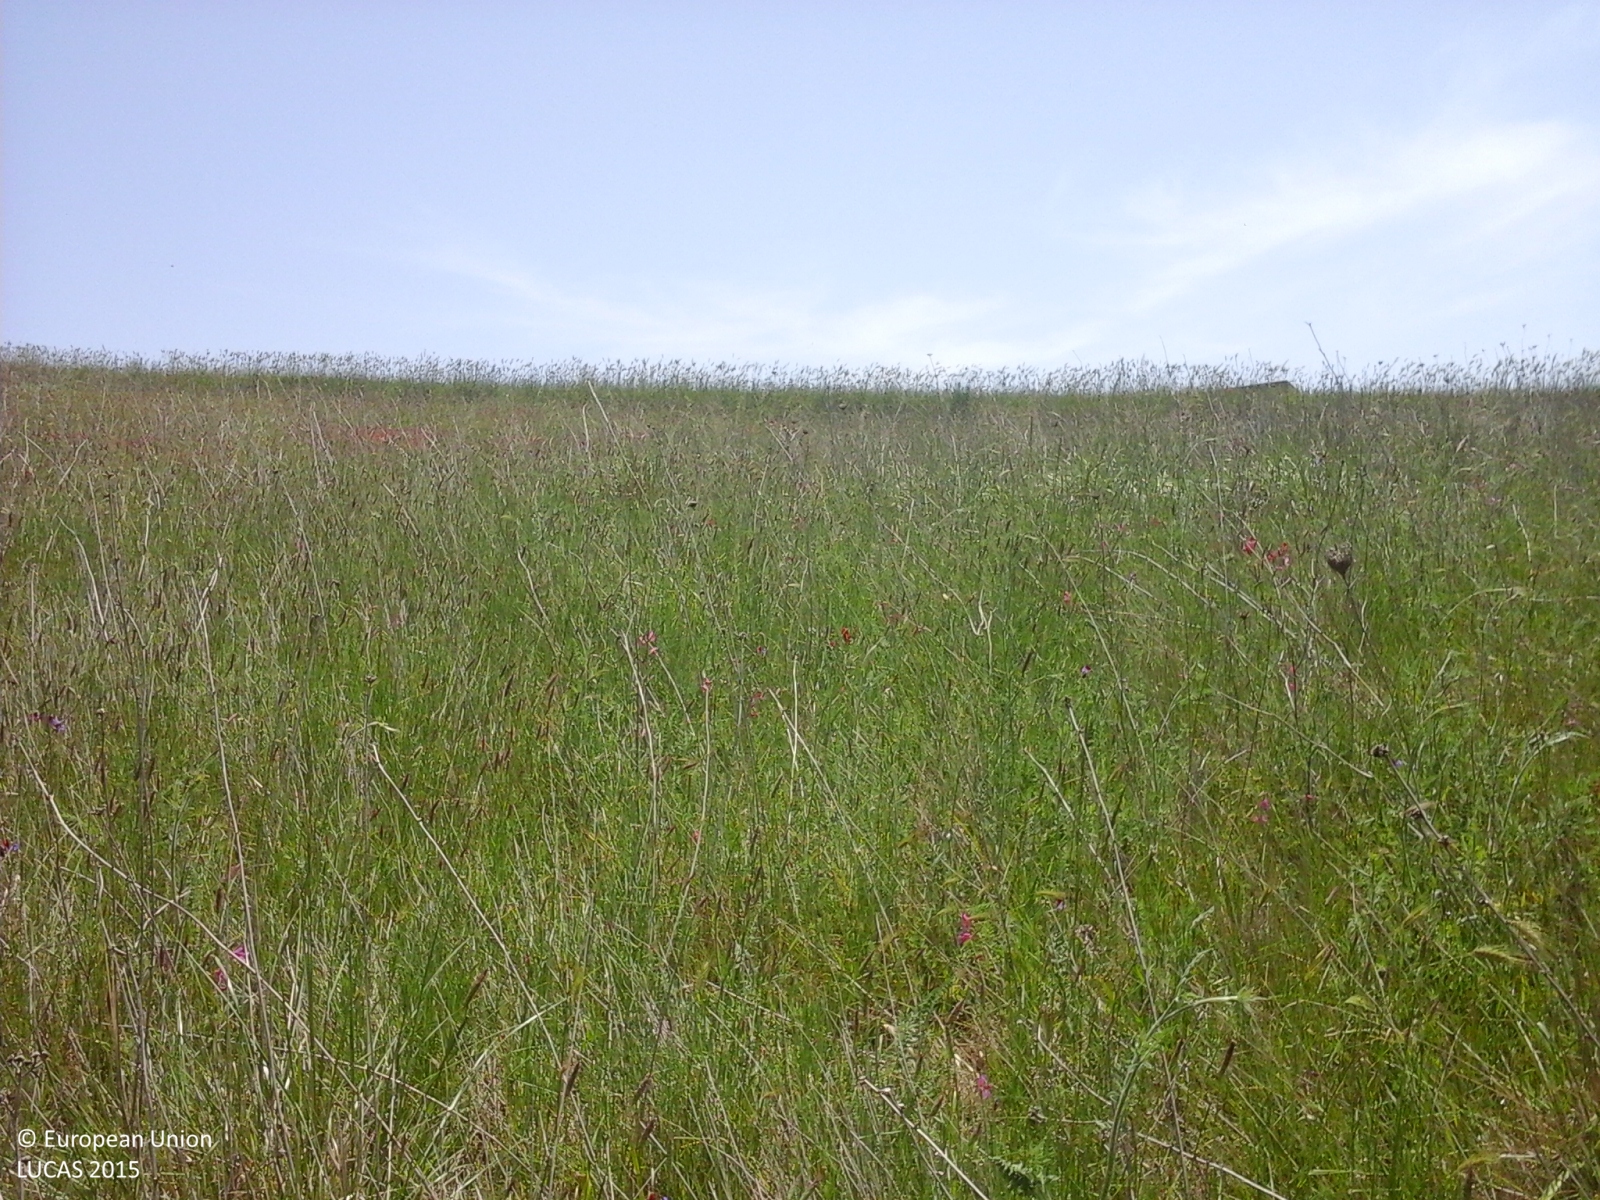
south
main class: Grassland
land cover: Spontaneously vegetated surfaces
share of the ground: > 75 %
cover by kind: herbaceous plants 100 %
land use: Fallow land
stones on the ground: < 10 %
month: May
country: IT
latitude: 37.7704
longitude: 14.0465
